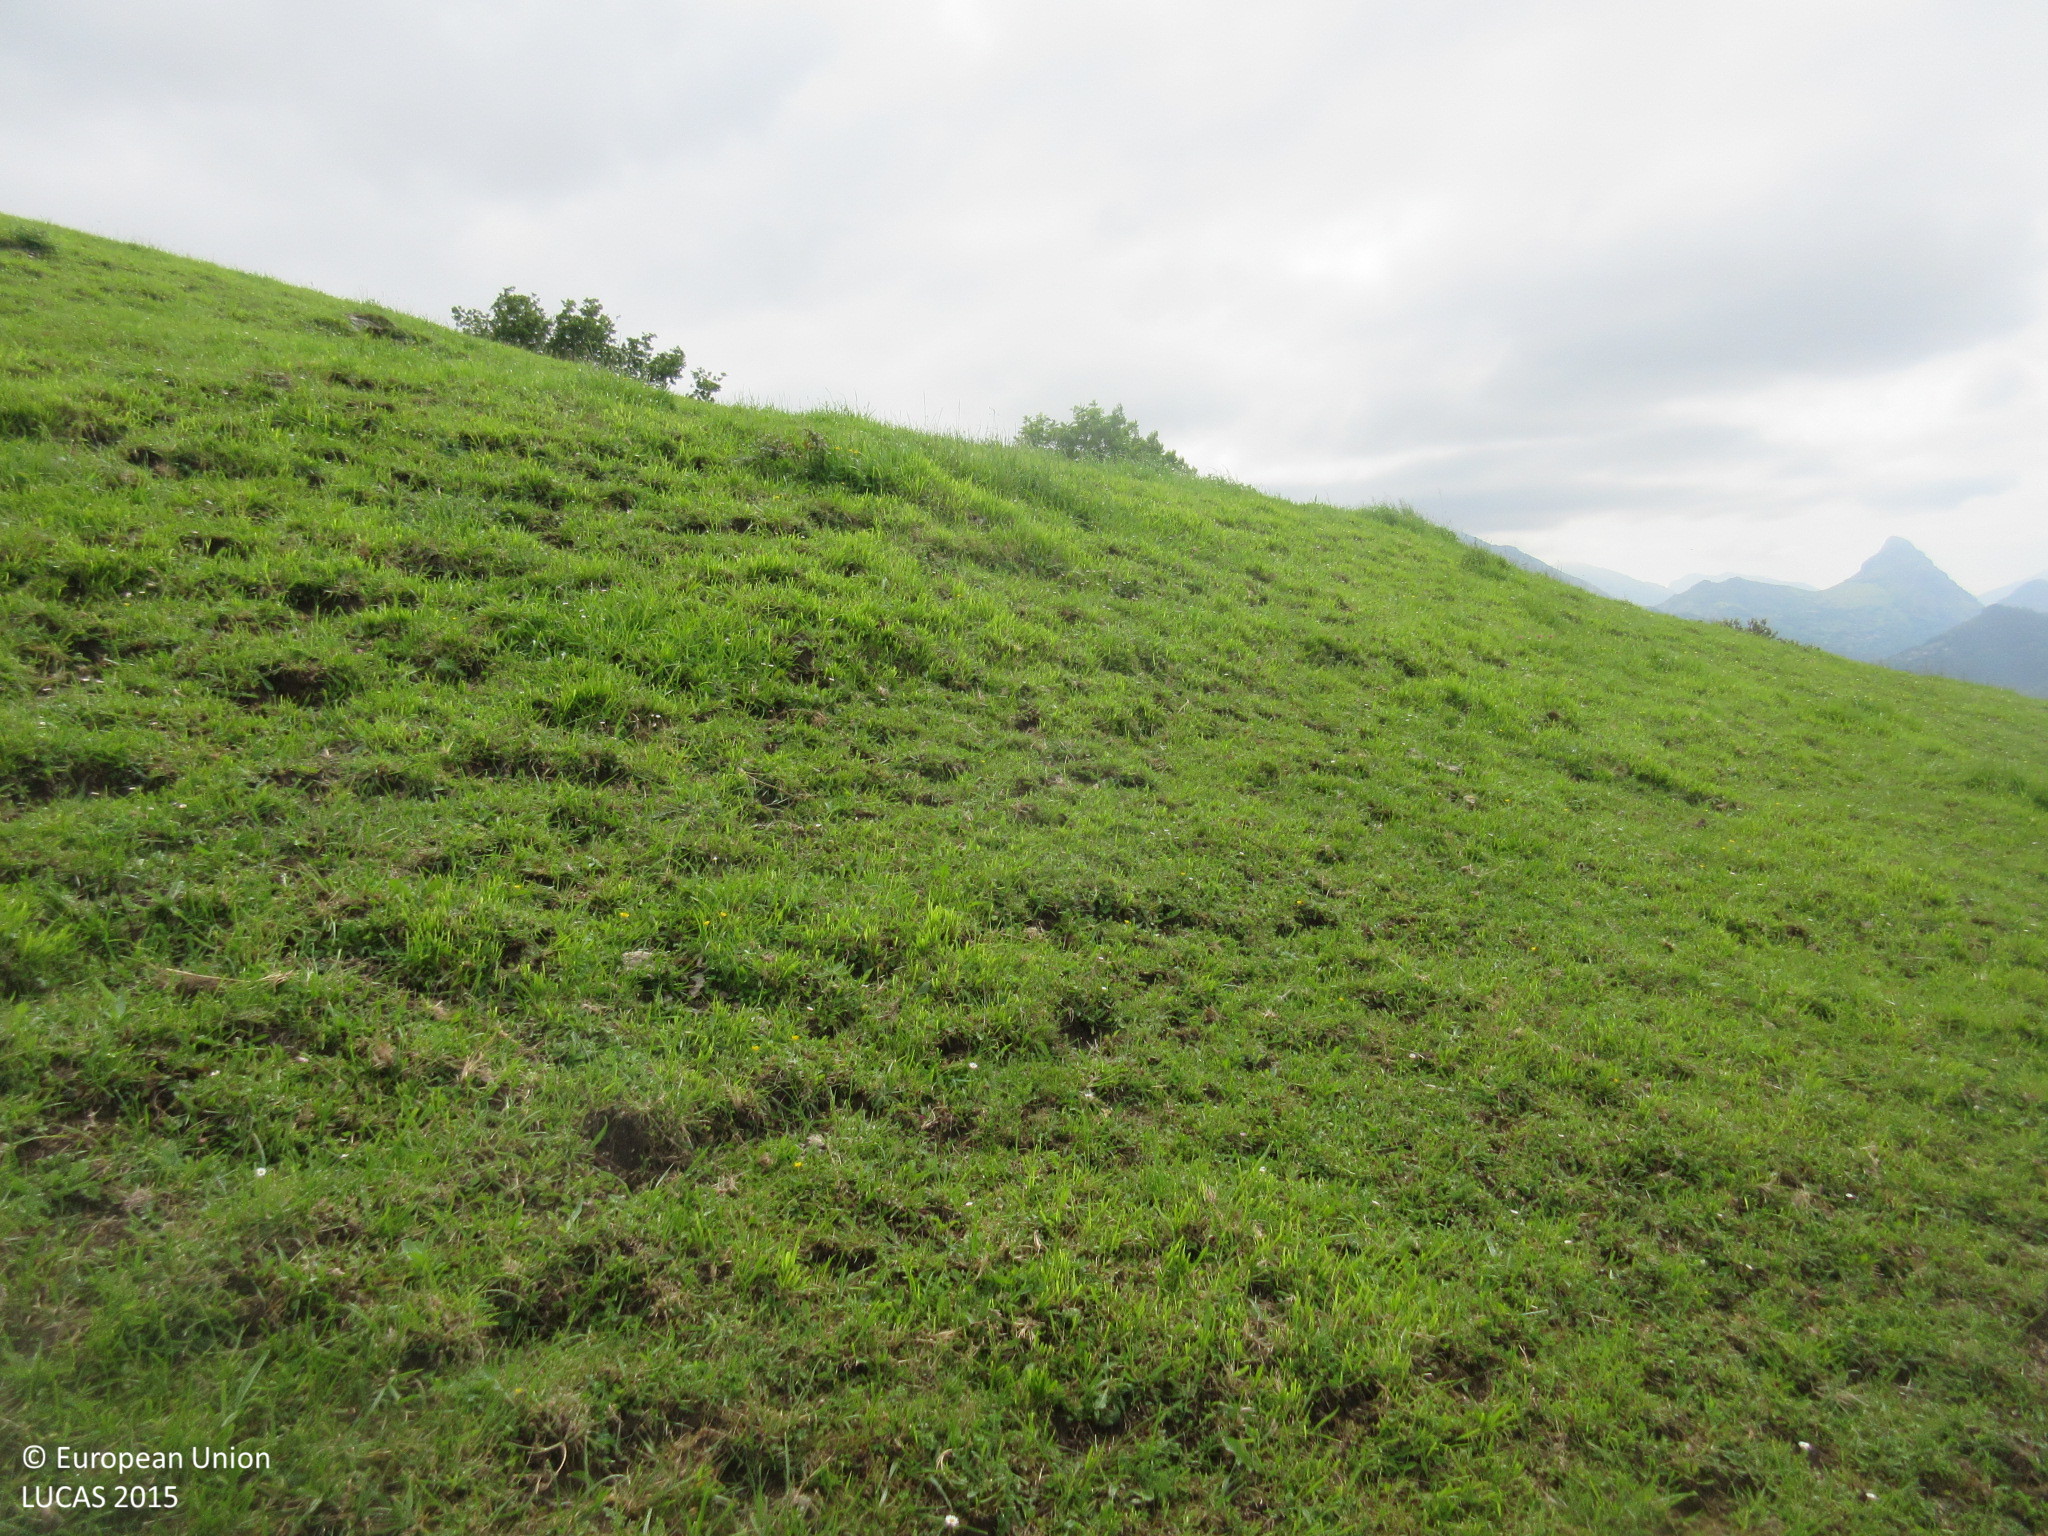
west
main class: Grassland
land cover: Grassland without tree/shrub cover
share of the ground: > 75 %
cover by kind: herbaceous plants 100 %
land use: Agriculture (excluding fallow land and kitchen gardens)
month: May
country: ES
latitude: 43.3187
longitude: -4.5492
